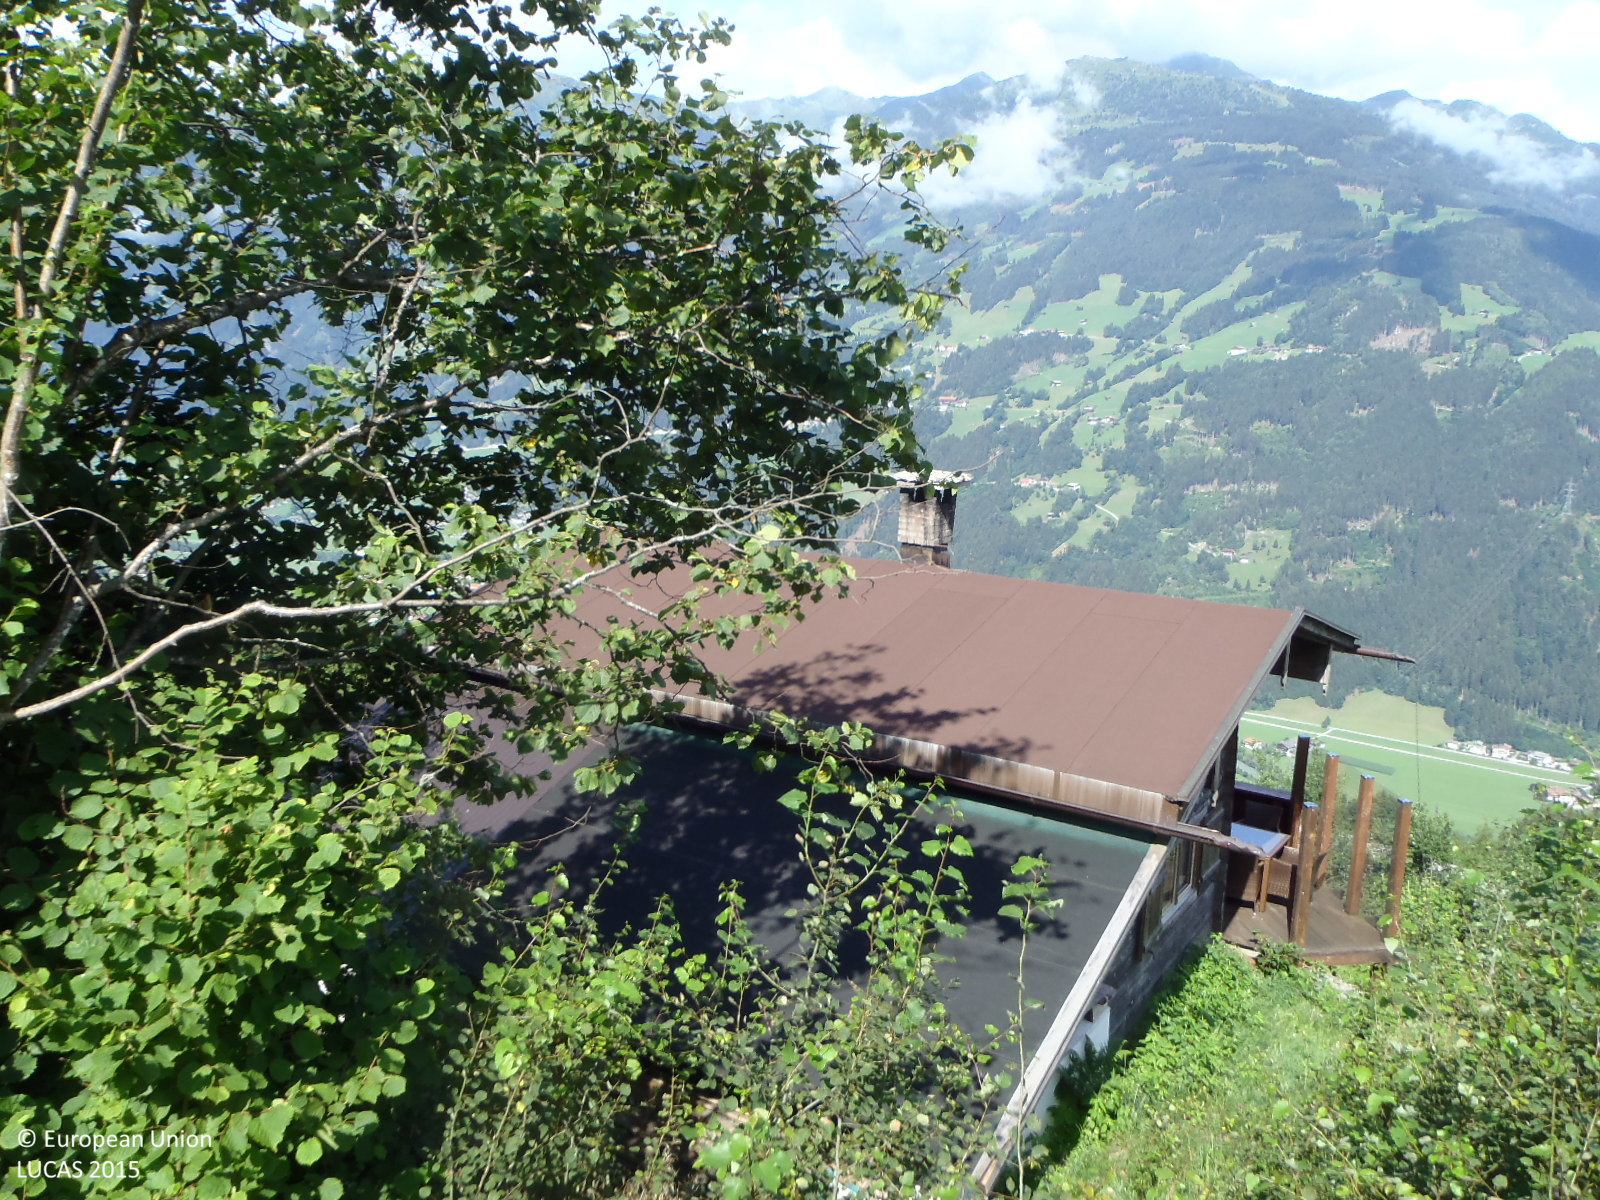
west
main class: Shrubland
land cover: Shrubland with sparse tree cover
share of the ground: > 75 %
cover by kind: shrubs 95 %, broadleaved forest trees 5 %
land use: Forestry
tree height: < 5 m
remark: Clear cut
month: July
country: AT
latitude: 47.2347
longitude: 11.9137
